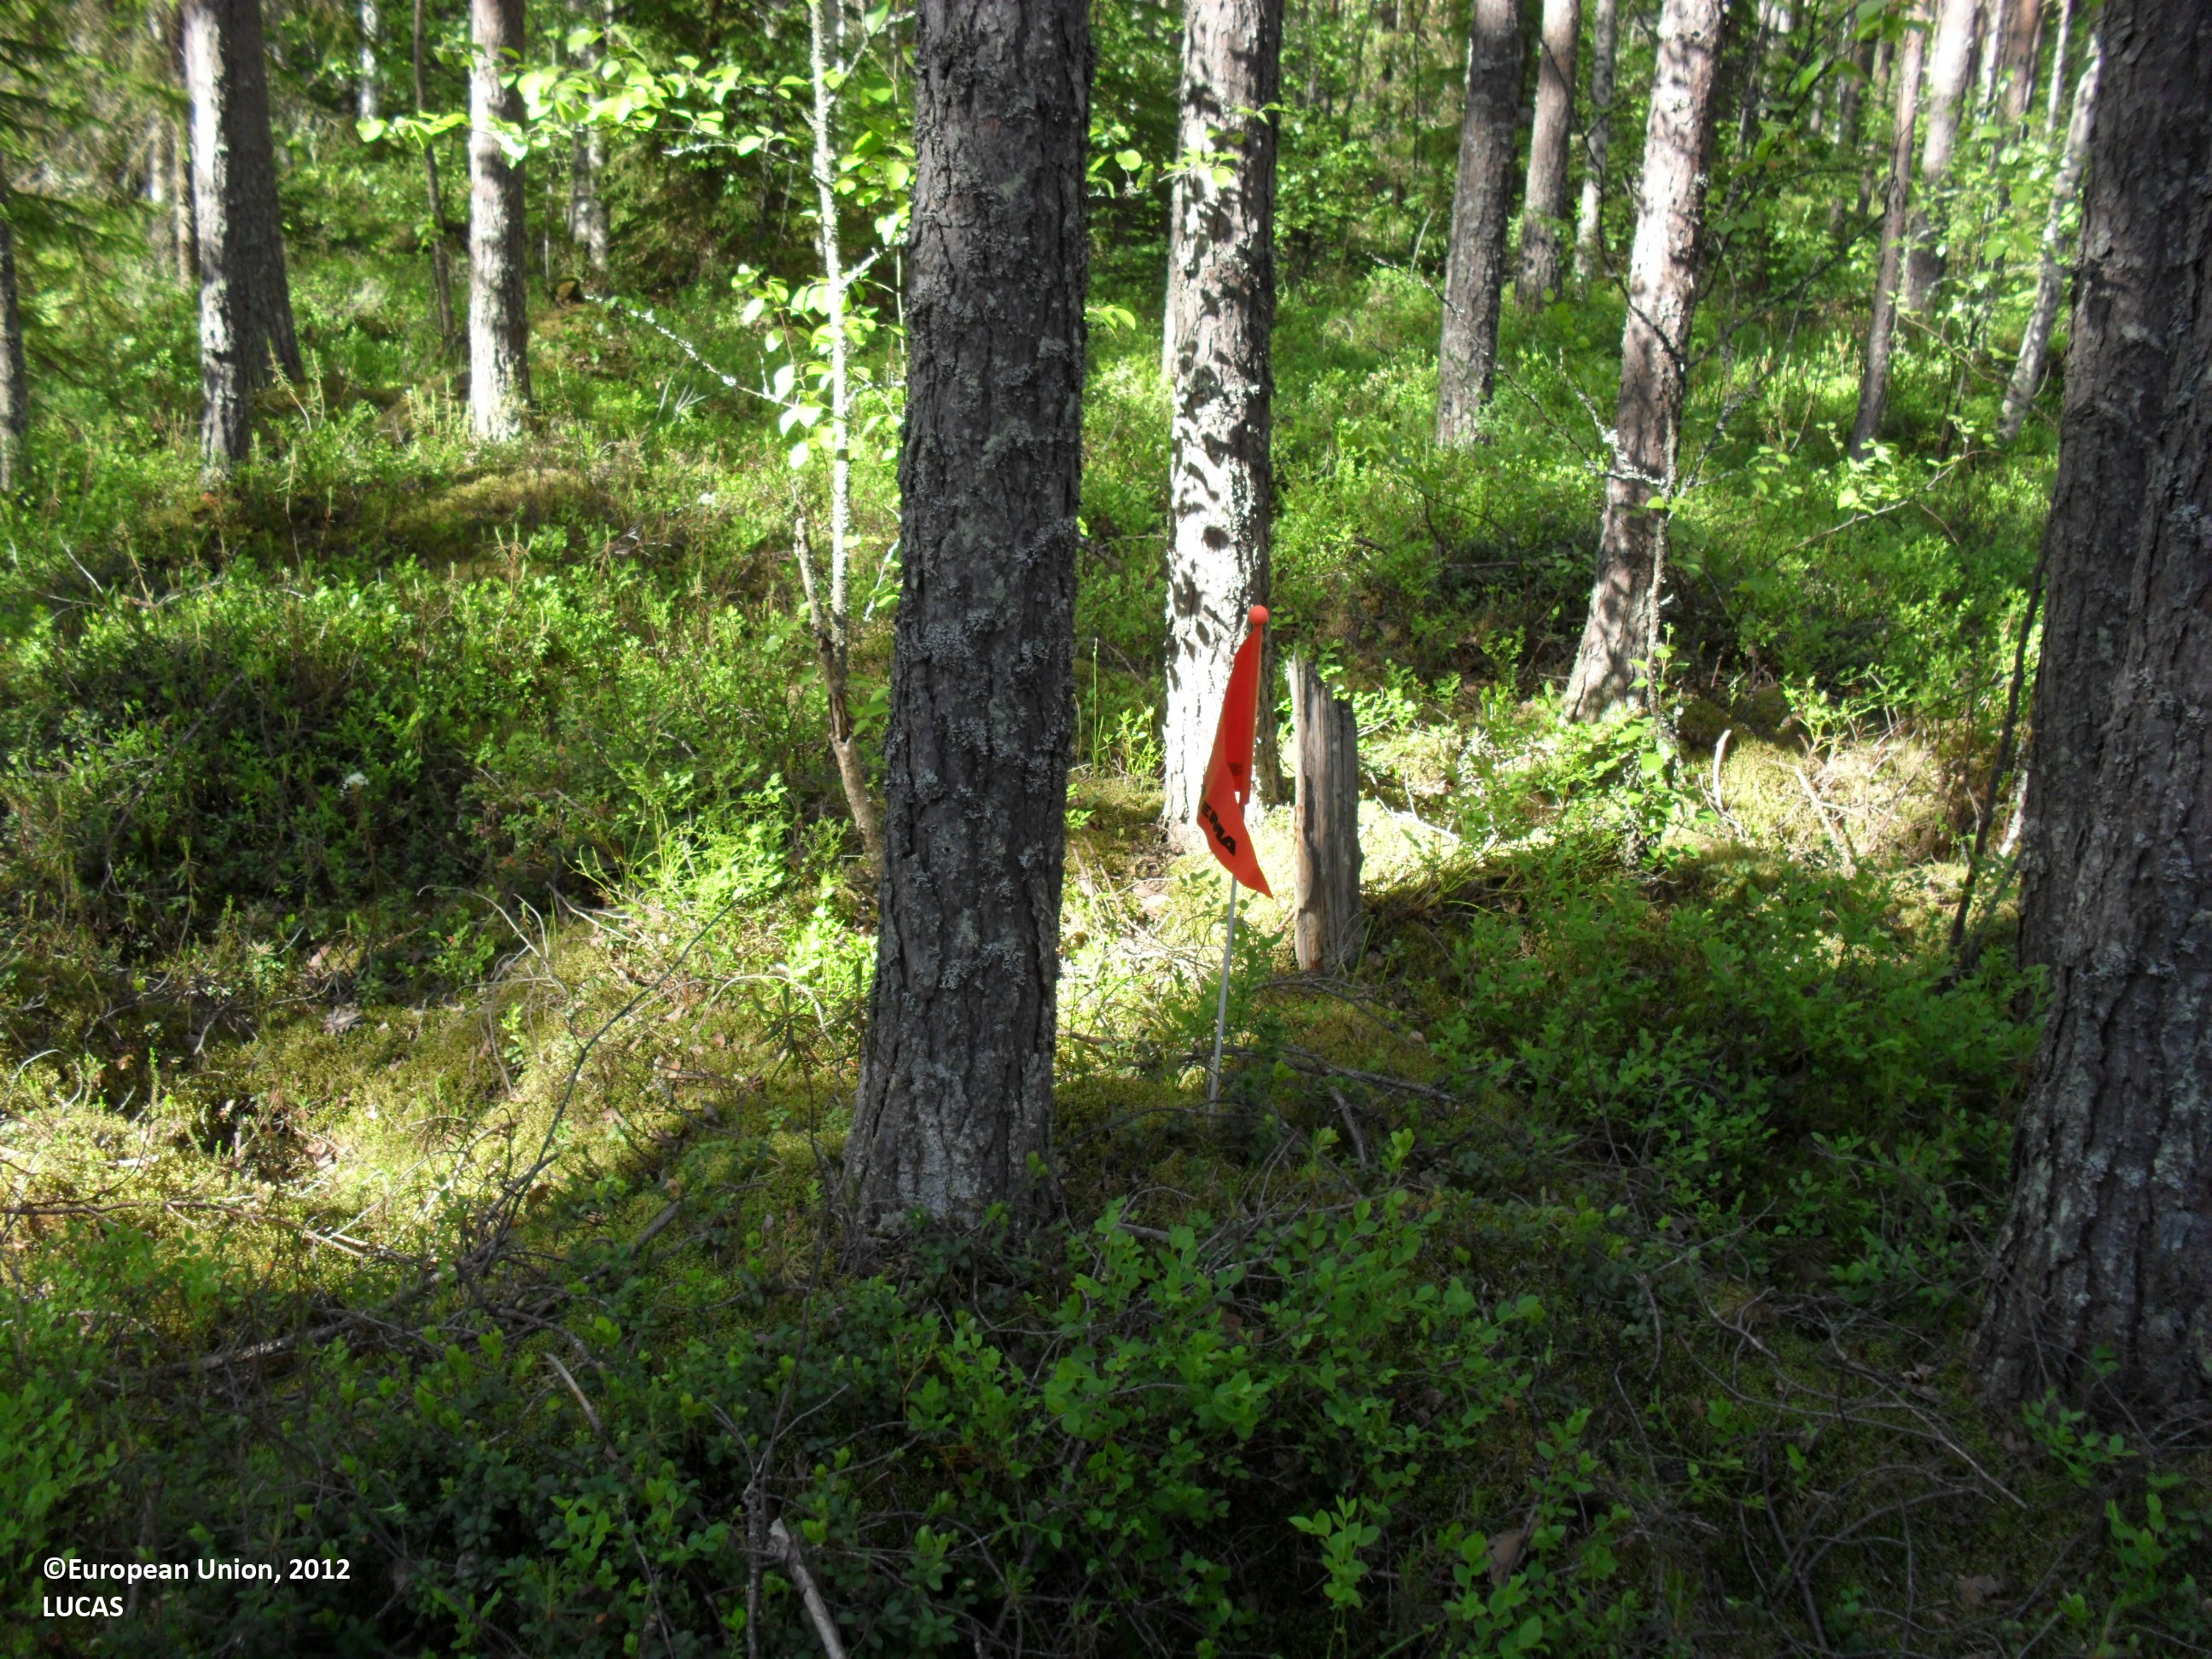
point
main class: Woodland
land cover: Pine dominated mixed woodland
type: boreal forest
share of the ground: 50 - 75 %
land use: Forestry
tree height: > 5 m
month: June
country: FI
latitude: 62.9482
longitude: 23.3684
